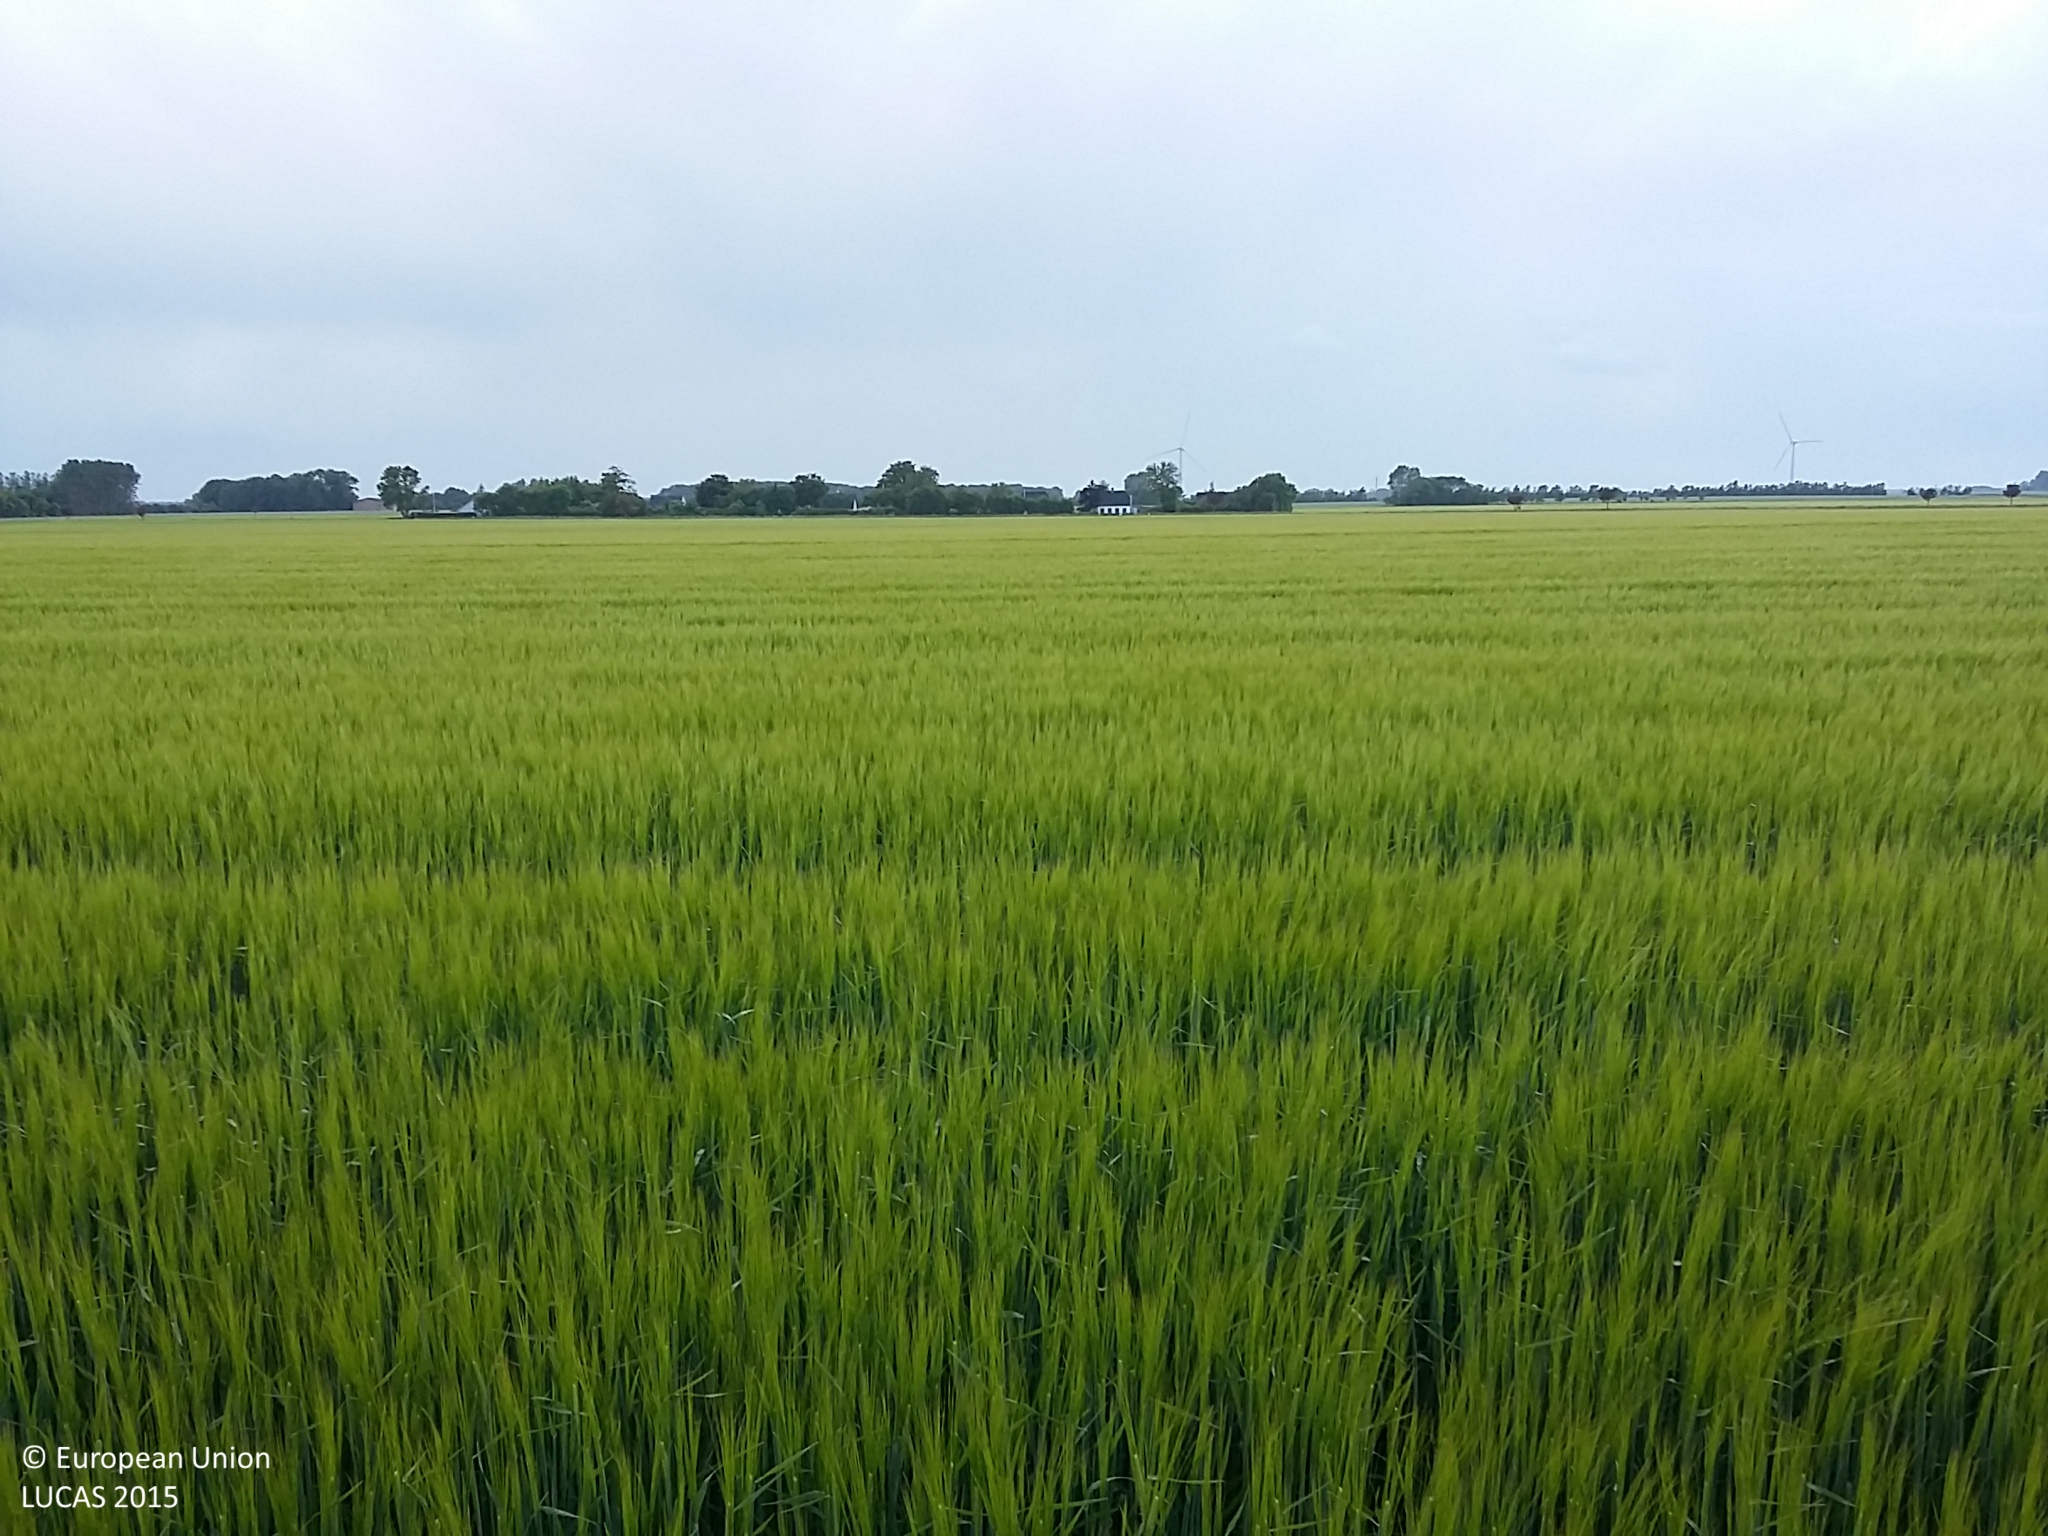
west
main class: Cropland
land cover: Barley
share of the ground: > 75 %
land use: Agriculture (excluding fallow land and kitchen gardens)
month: June
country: DK
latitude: 54.7797
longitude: 11.2274
